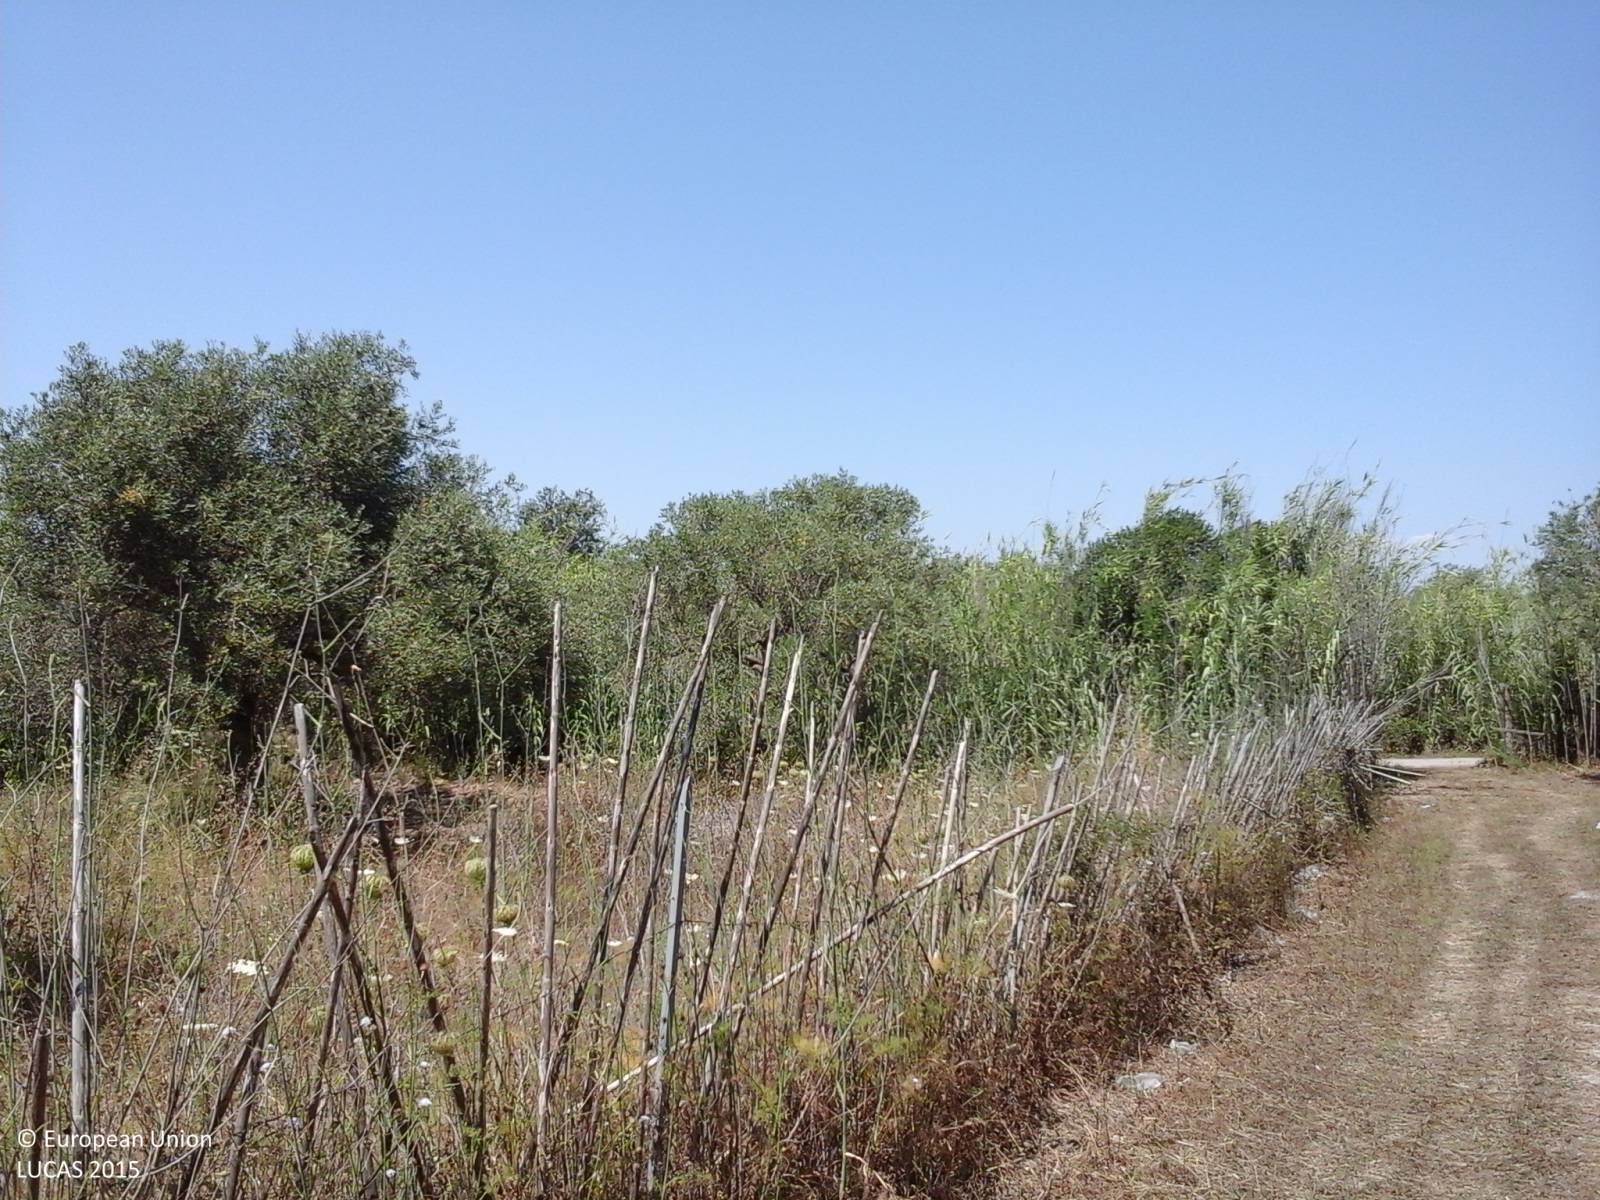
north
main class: Cropland
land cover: Olive groves
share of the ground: > 75 %
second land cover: Grassland without tree/shrub cover
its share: > 75 %
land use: Agriculture (excluding fallow land and kitchen gardens)
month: July
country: IT
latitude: 39.9665
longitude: 8.5212
